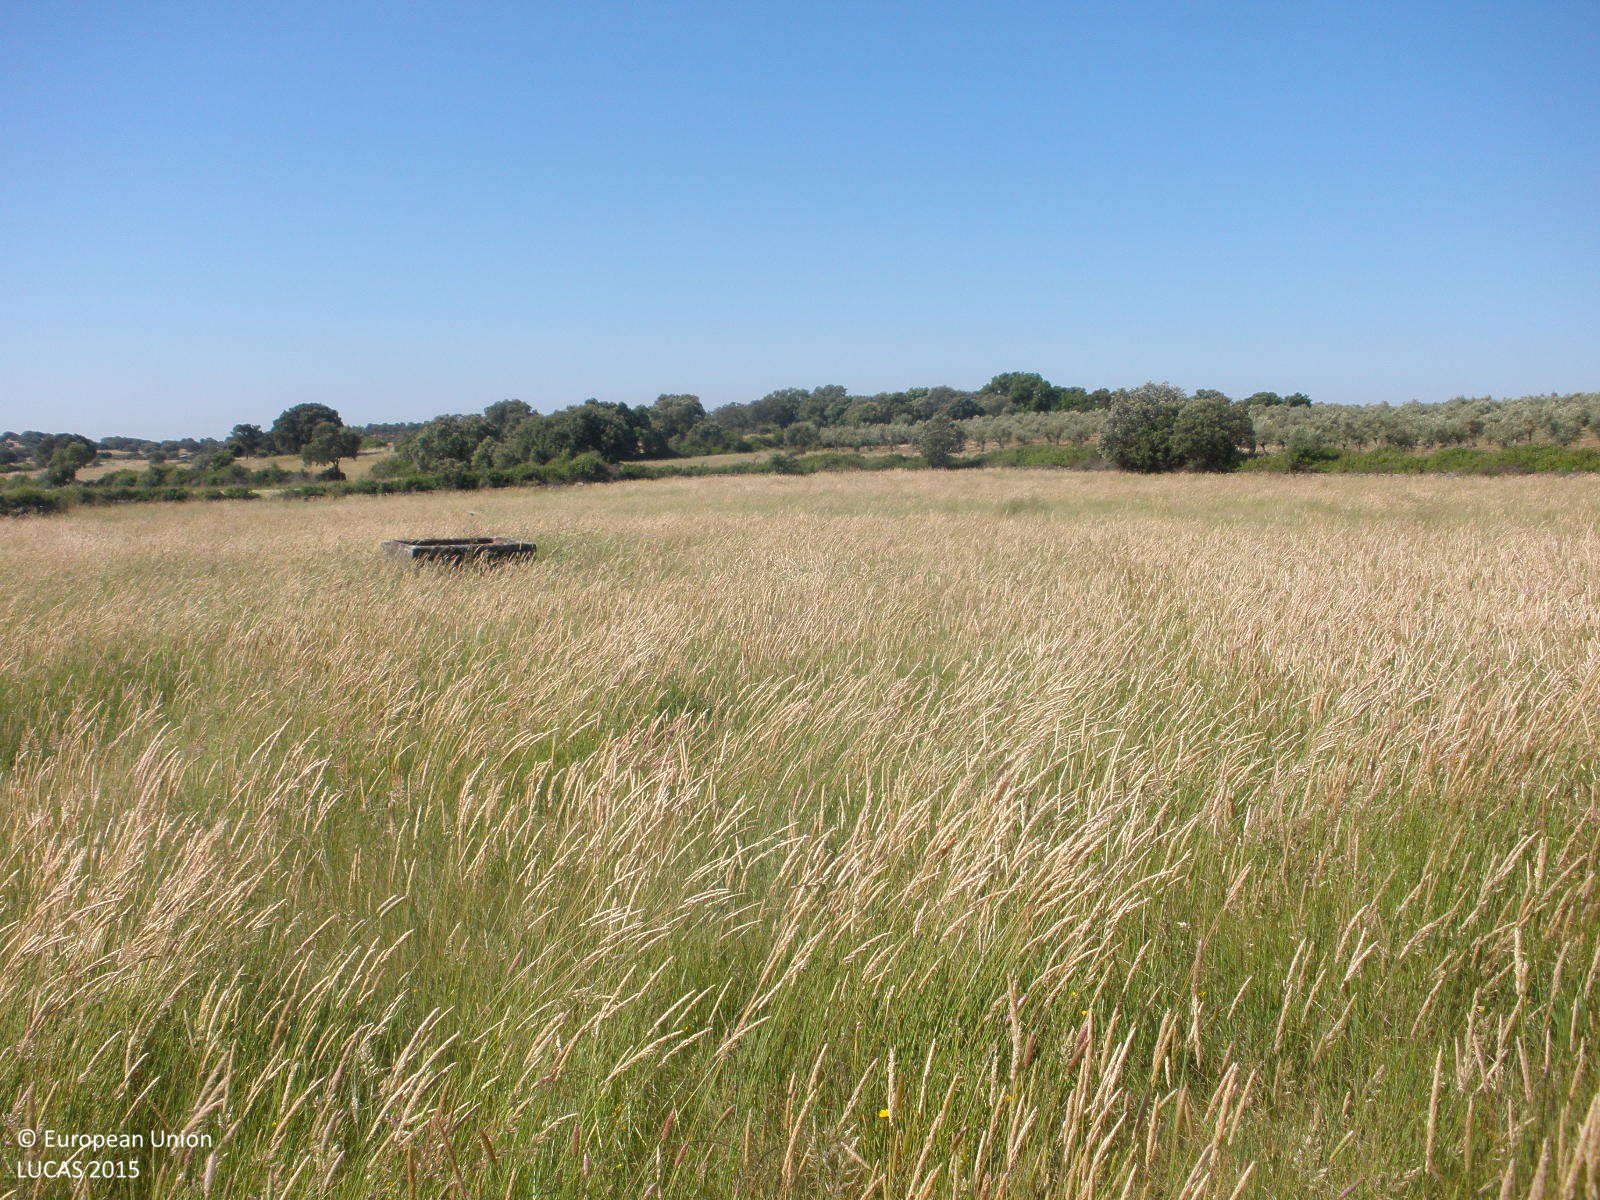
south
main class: Grassland
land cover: Grassland without tree/shrub cover
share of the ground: > 75 %
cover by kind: herbaceous plants 100 %
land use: Agriculture (excluding fallow land and kitchen gardens)
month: May
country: ES
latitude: 40.2398
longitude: -6.2883
